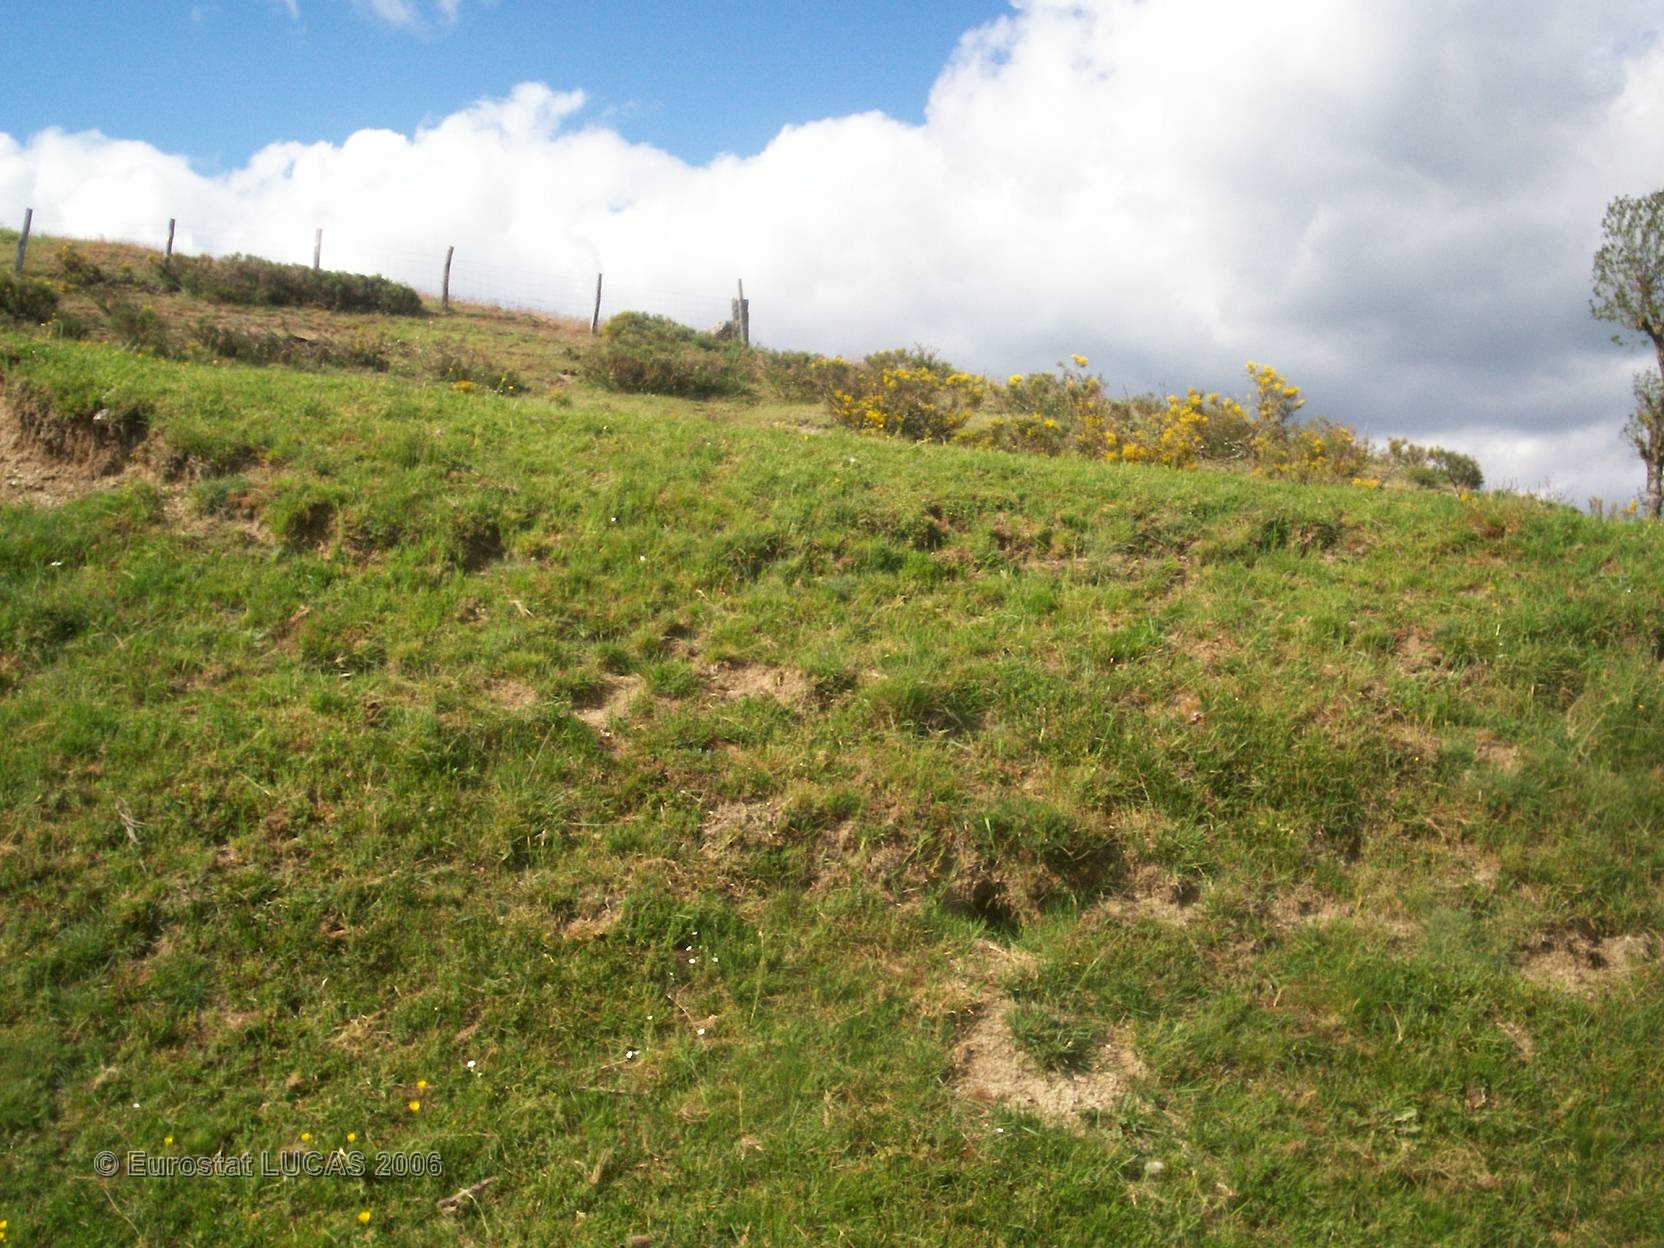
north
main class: Grassland
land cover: Grassland with sparse tree/shrub cover
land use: Agriculture (excluding fallow land and kitchen gardens)
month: May
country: FR
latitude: 44.7177
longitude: 3.3766
